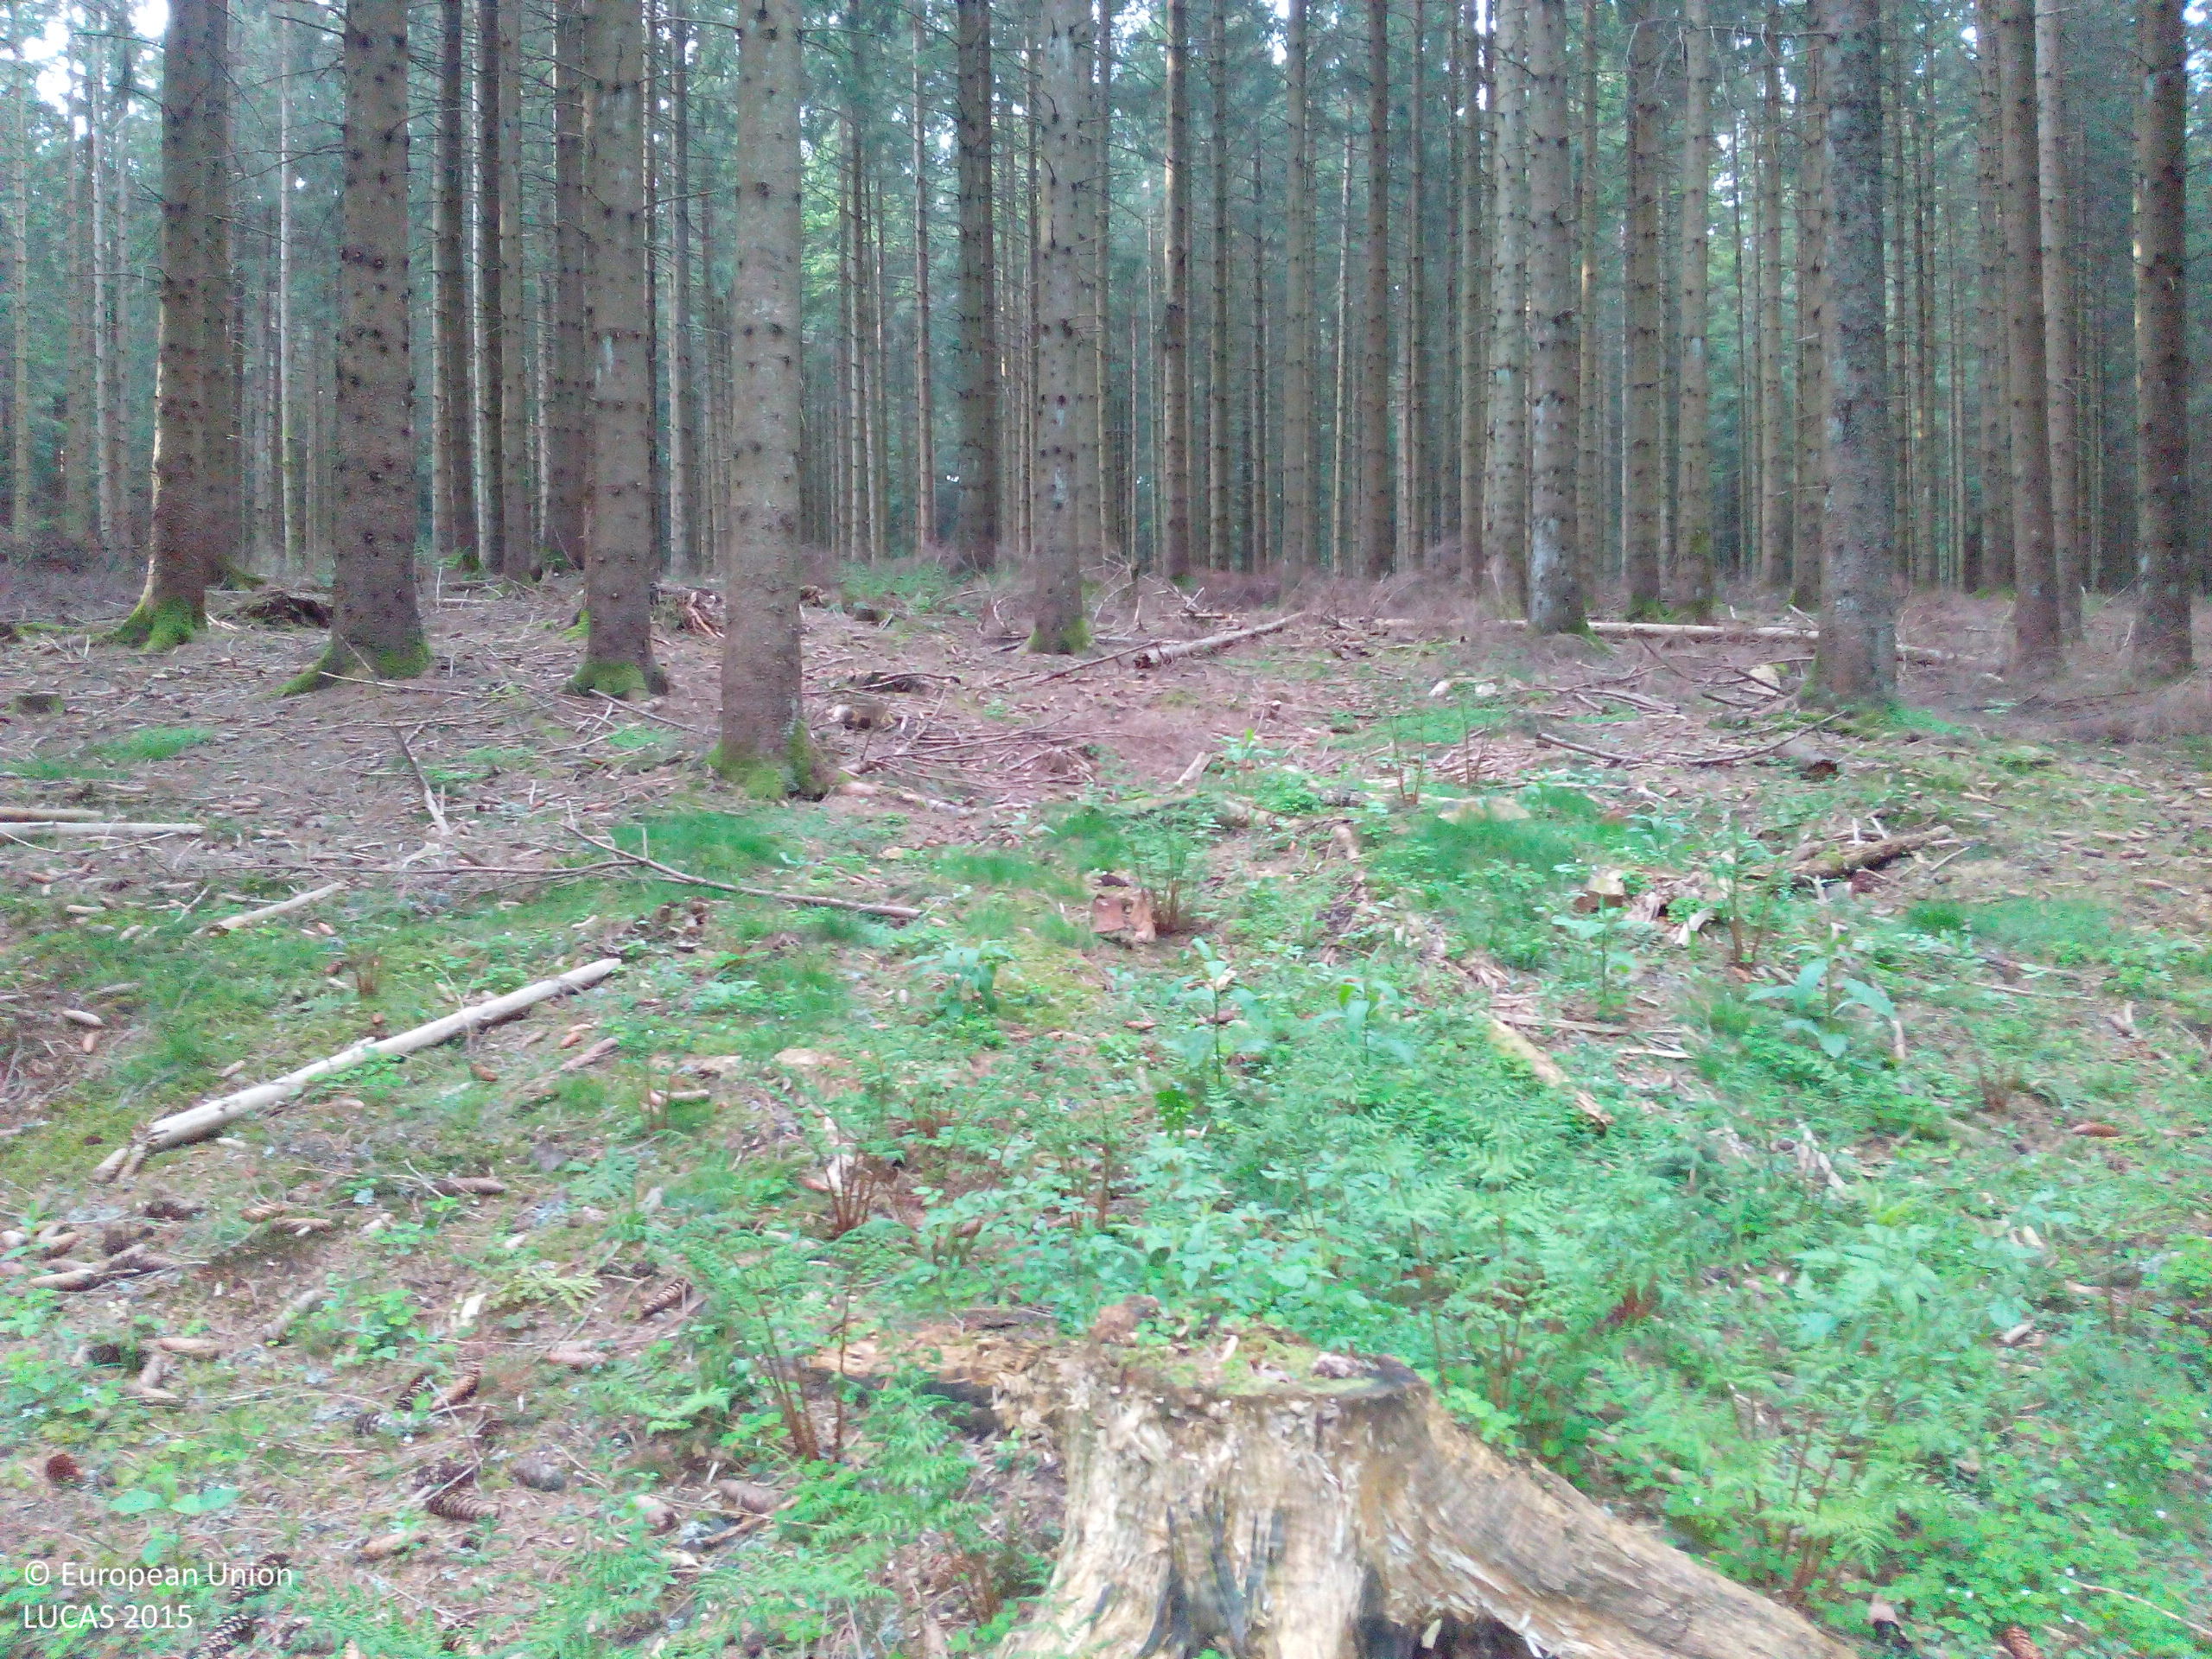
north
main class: Woodland
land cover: Spruce dominated coniferous woodland
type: hemiboreal forest and nemoral coniferous forest and mixed broadleaved-coniferous forest
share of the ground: > 75 %
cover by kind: coniferous forest trees 95 %, herbaceous plants 5 %
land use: Forestry
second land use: Amenities, museums, leisure
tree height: > 5 m
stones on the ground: < 10 %
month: May
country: DE
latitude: 48.1007
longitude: 8.1881
